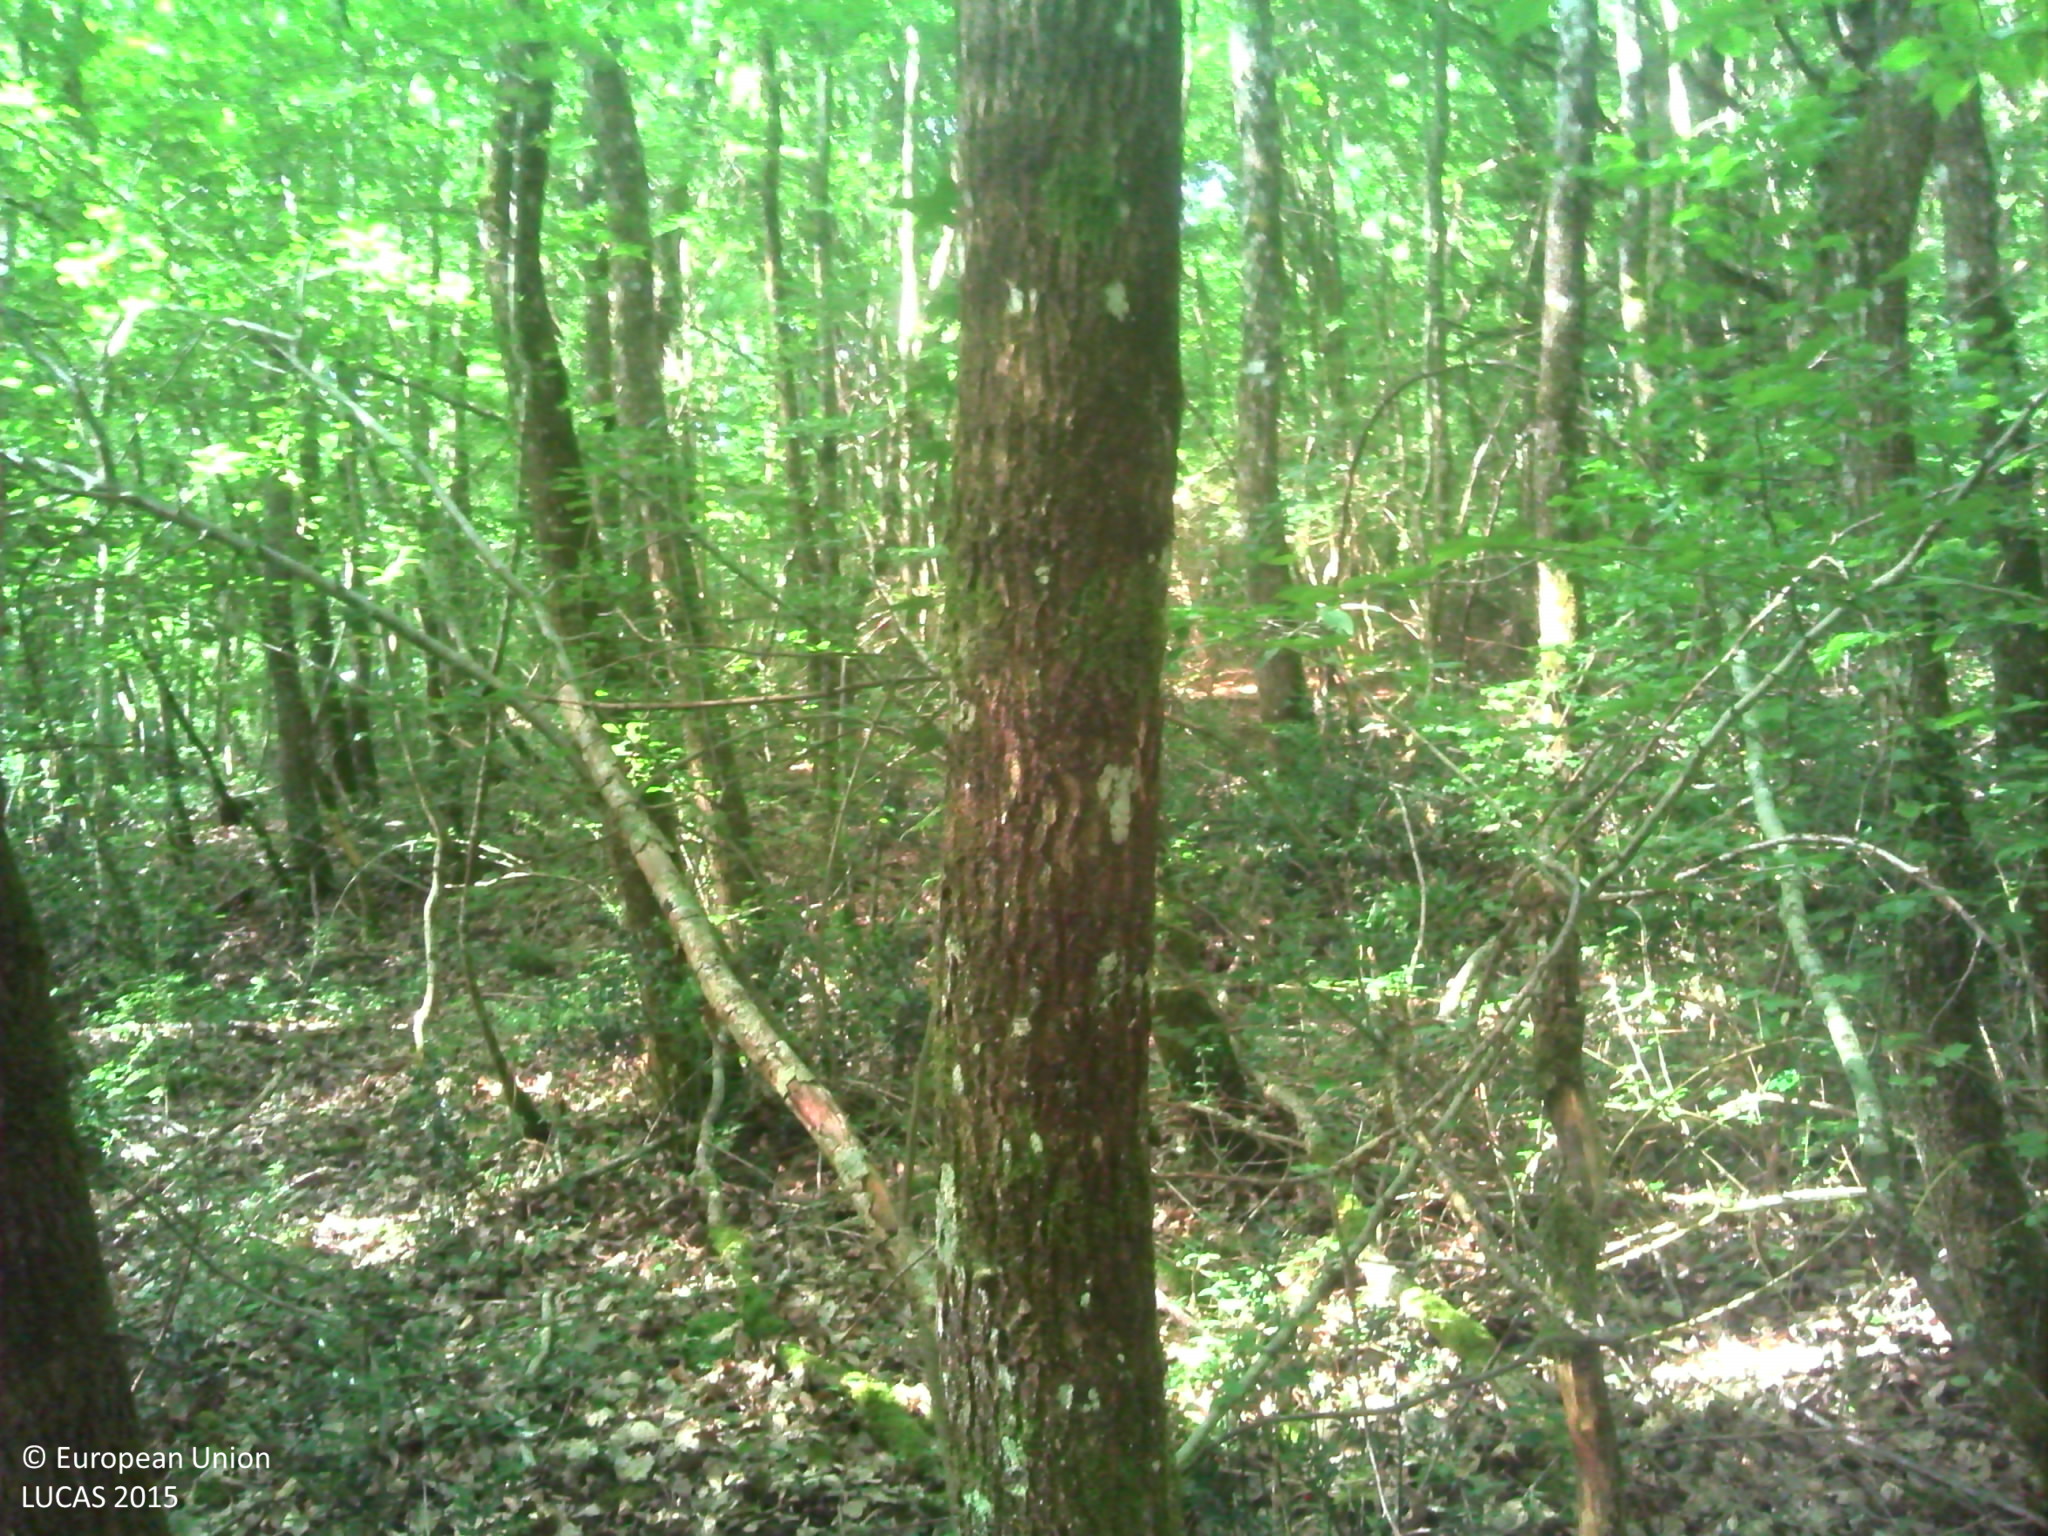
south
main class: Woodland
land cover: Broadleaved woodland
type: mesophytic deciduous forest
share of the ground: > 75 %
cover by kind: unconsolidated bare surface 50 %, herbaceous plants 30 %, broadleaved forest trees 20 %
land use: Forestry
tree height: > 5 m
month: June
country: FR
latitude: 47.5224
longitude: 1.3659
